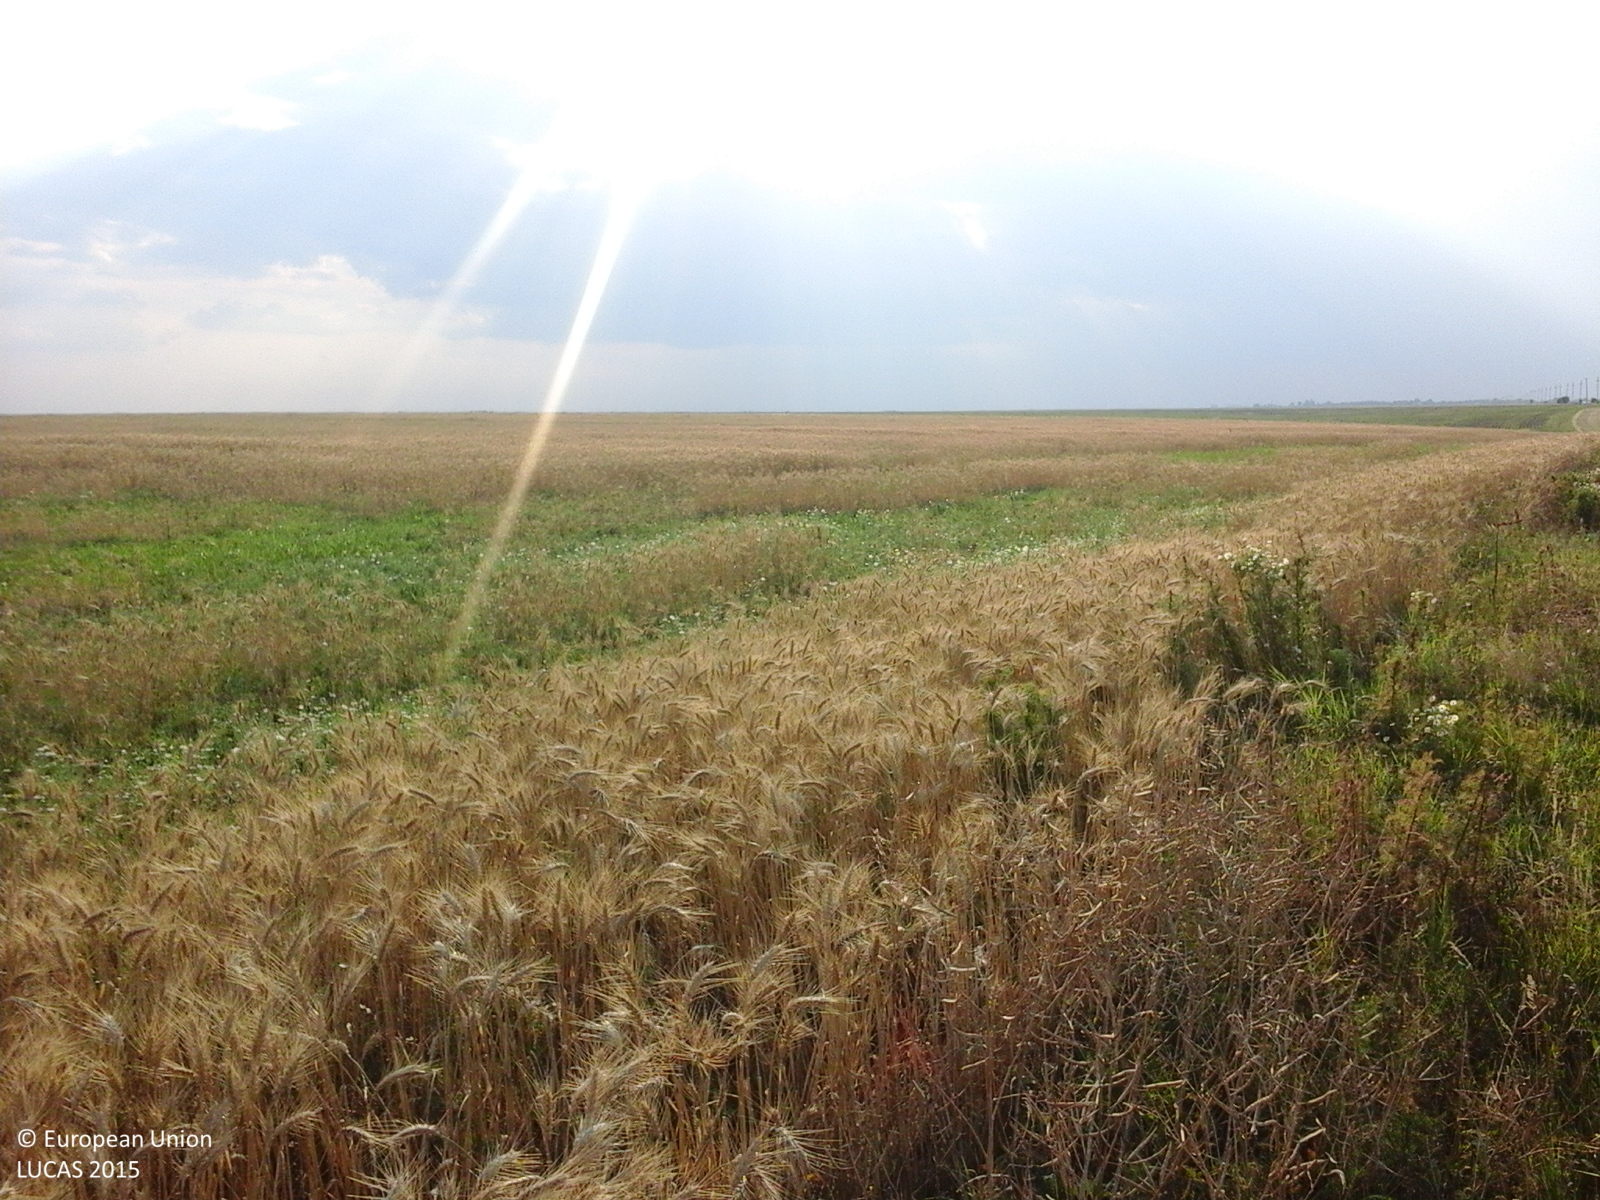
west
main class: Cropland
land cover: Common wheat
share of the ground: > 75 %
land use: Agriculture (excluding fallow land and kitchen gardens)
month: July
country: RO
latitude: 44.1623
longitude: 24.9197
